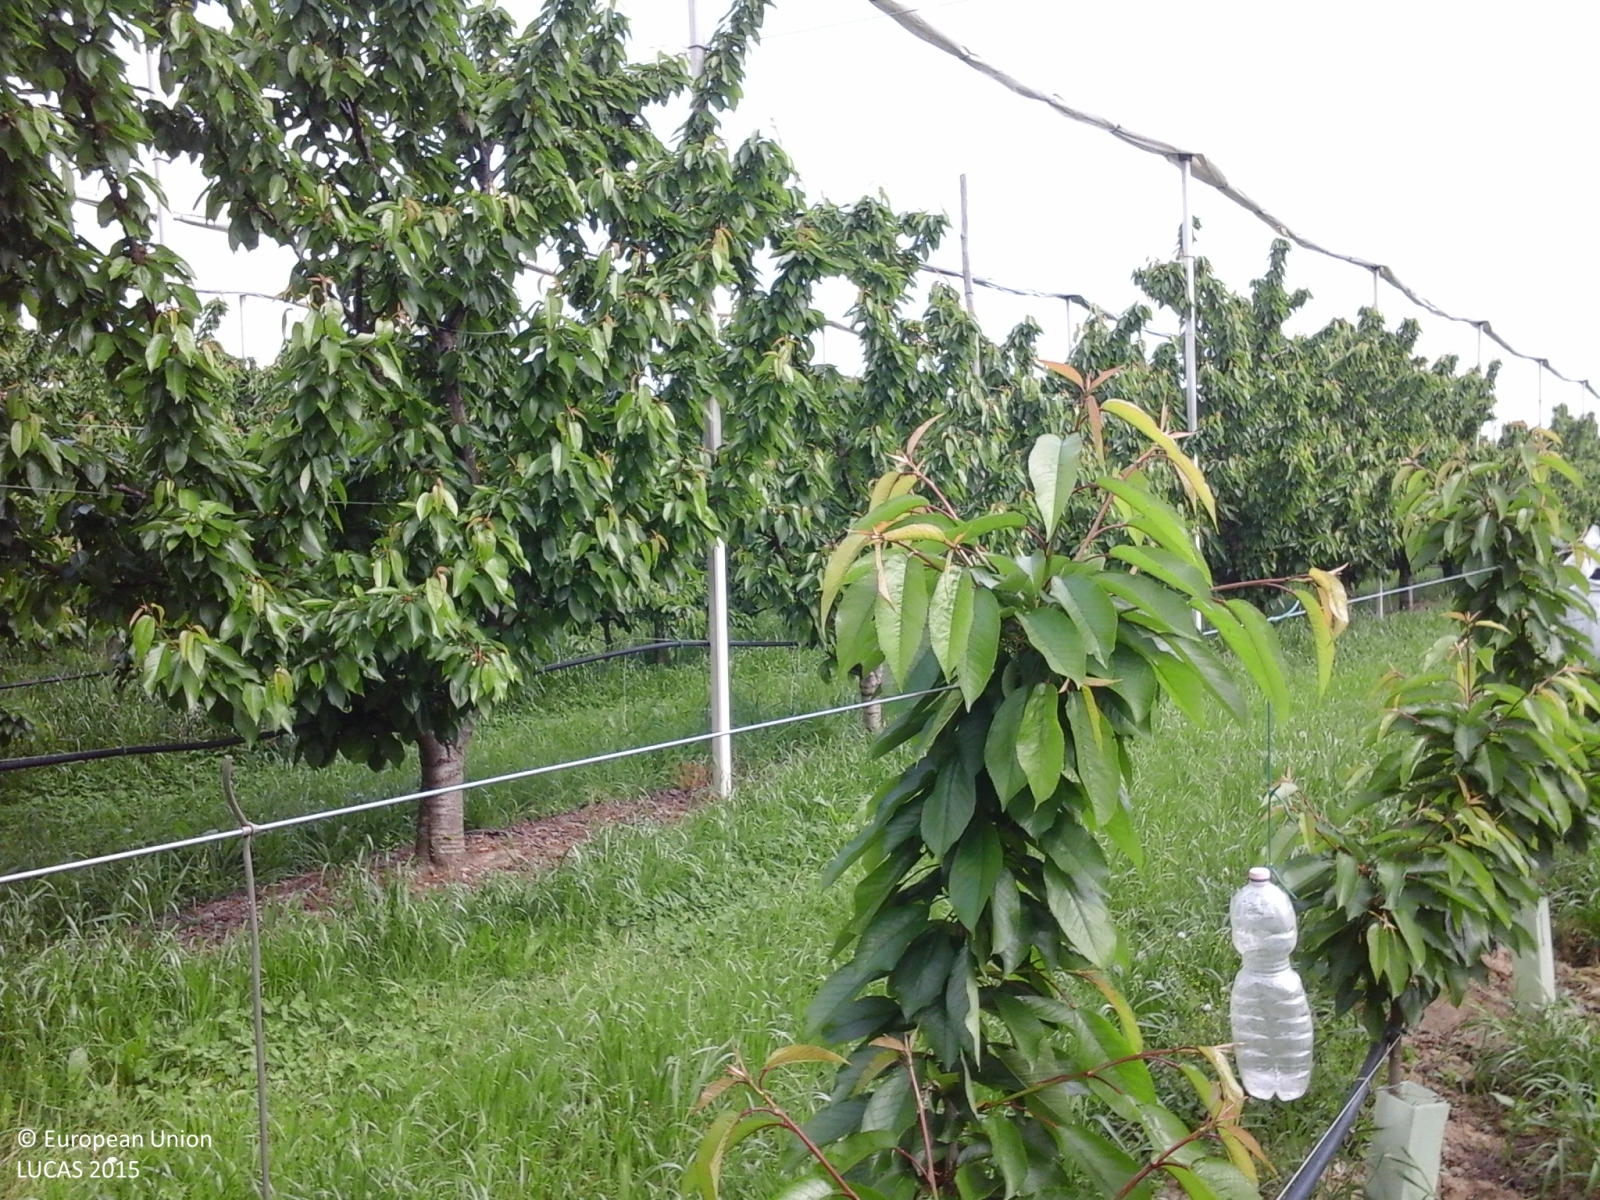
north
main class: Cropland
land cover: Cherry fruit
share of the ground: 50 - 75 %
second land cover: Grassland without tree/shrub cover
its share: > 75 %
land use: Agriculture (excluding fallow land and kitchen gardens)
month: May
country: IT
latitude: 44.4896
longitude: 11.0414
